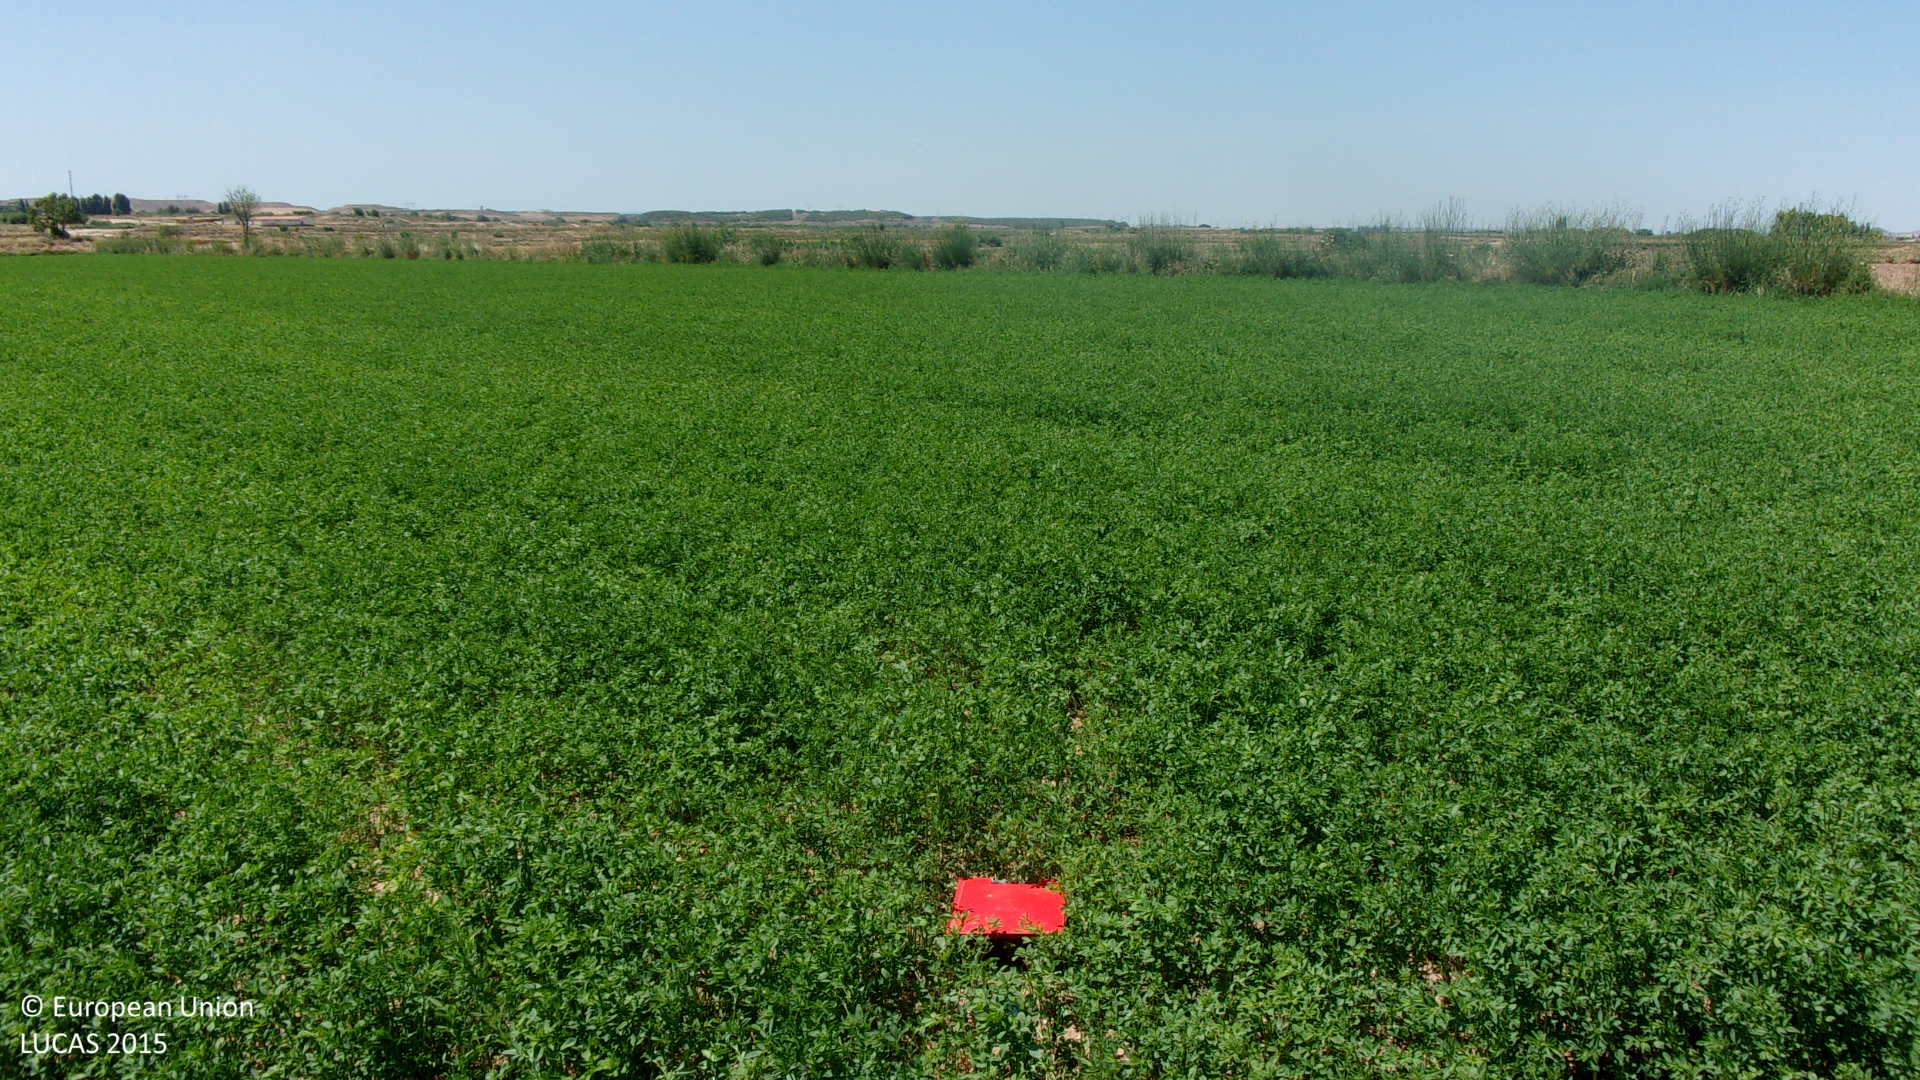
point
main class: Cropland
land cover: Lucerne
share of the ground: > 75 %
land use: Agriculture (excluding fallow land and kitchen gardens)
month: July
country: ES
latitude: 41.9598
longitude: -1.5039
